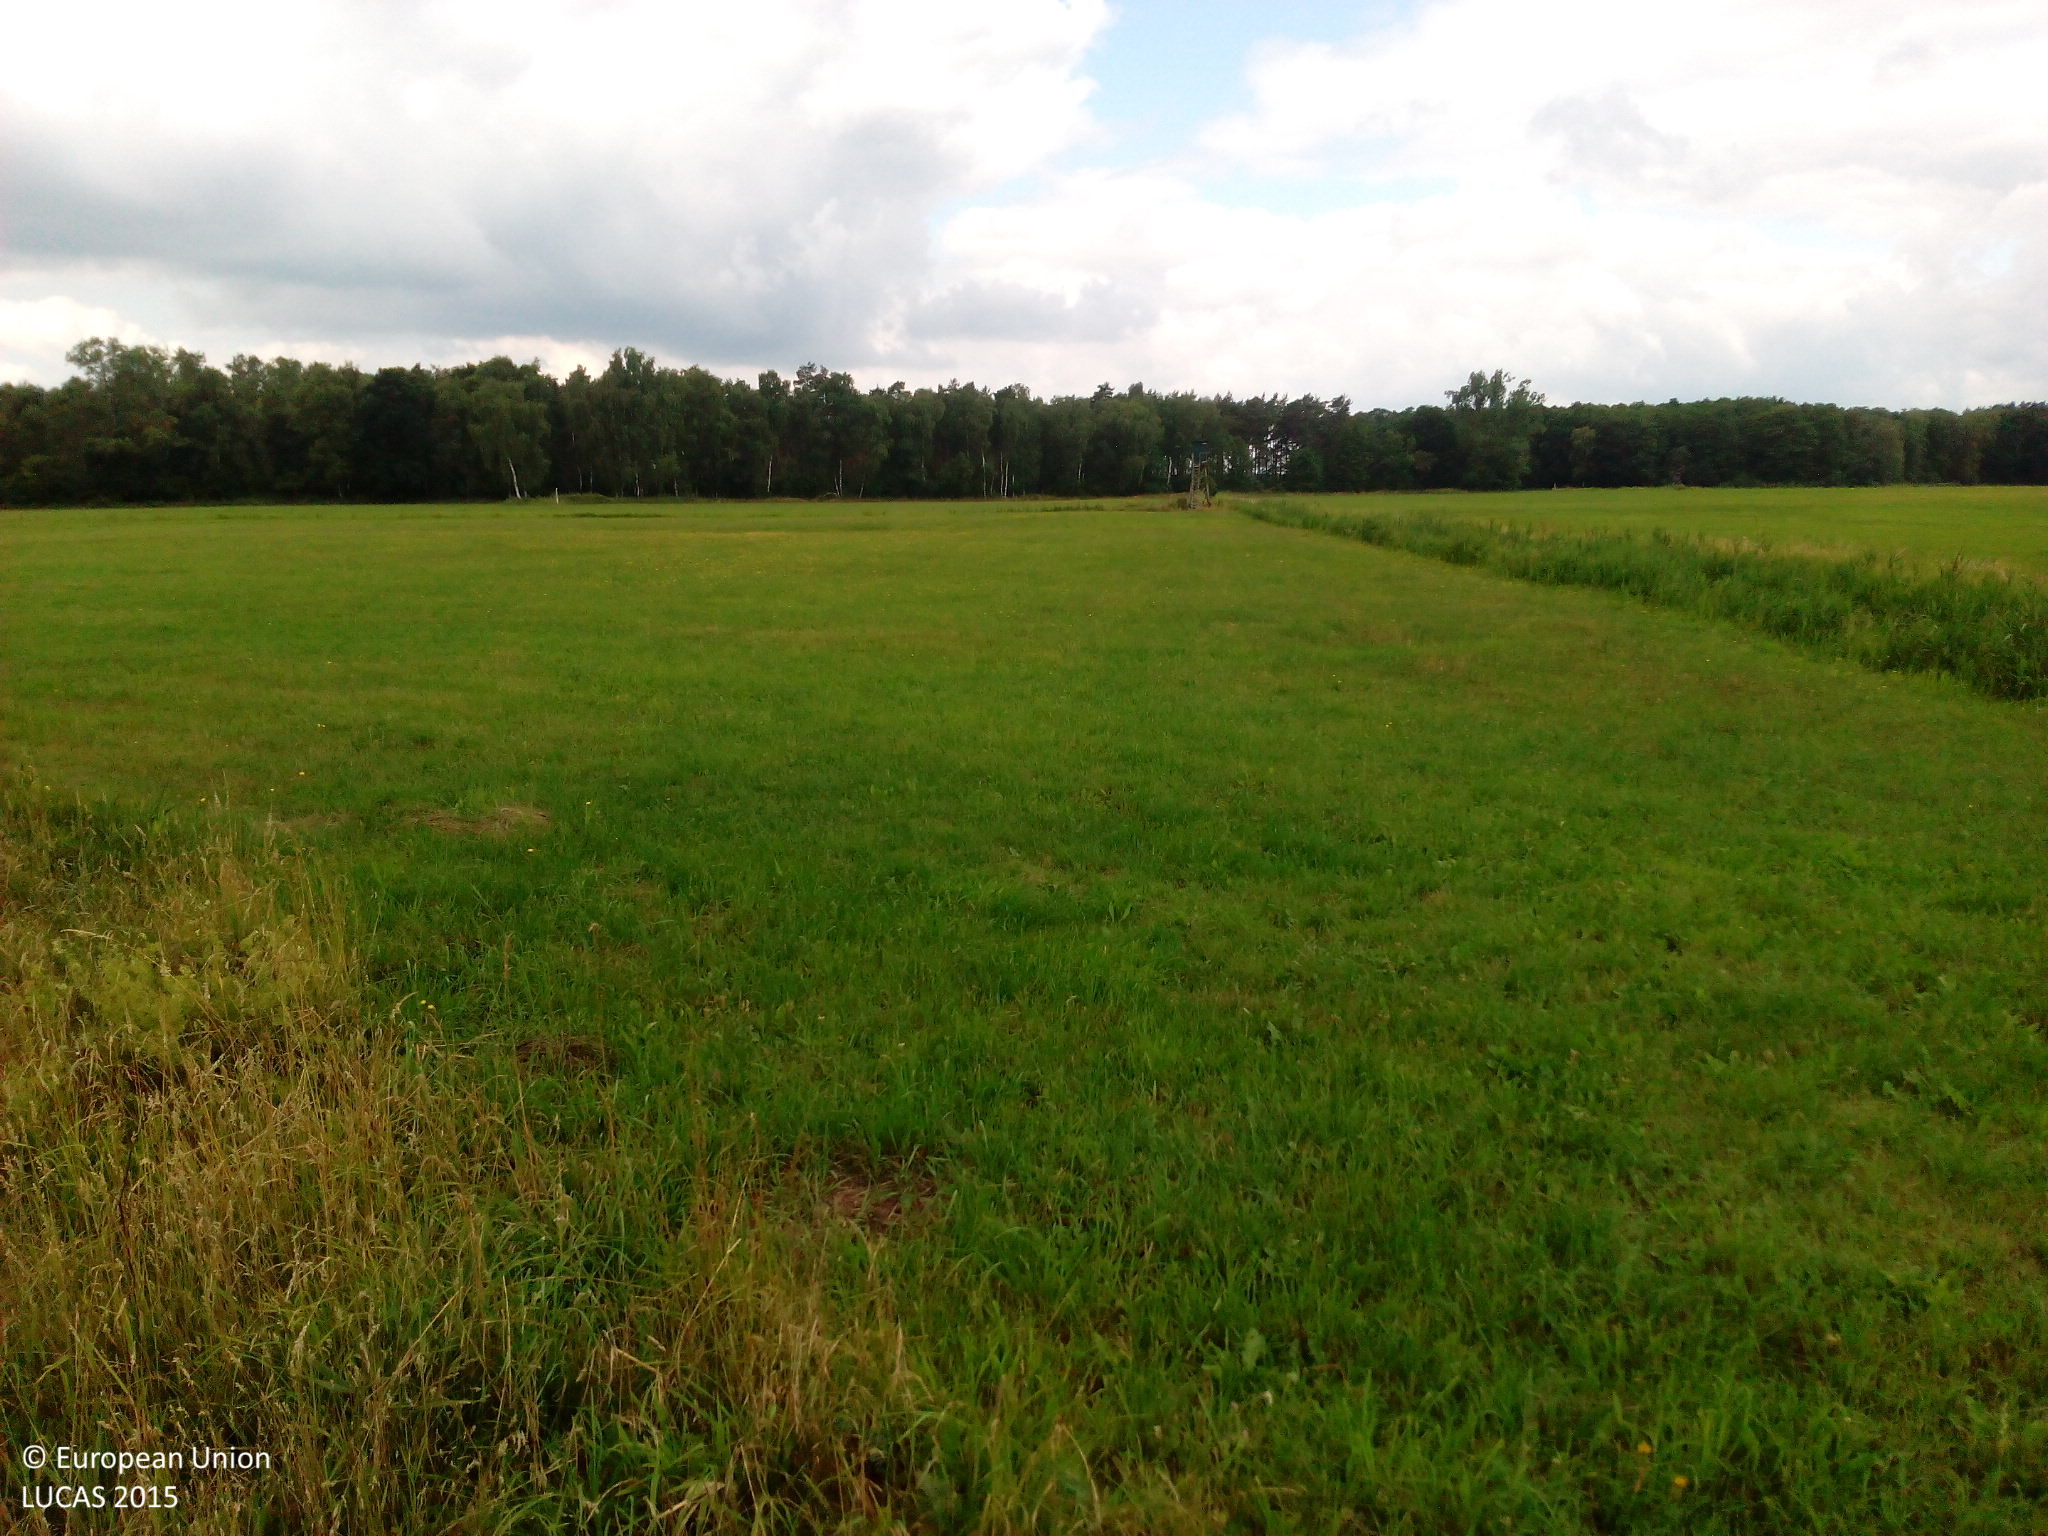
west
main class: Grassland
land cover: Grassland without tree/shrub cover
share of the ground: > 75 %
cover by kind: herbaceous plants 100 %
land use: Agriculture (excluding fallow land and kitchen gardens)
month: July
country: DE
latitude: 52.7114
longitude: 12.4715
